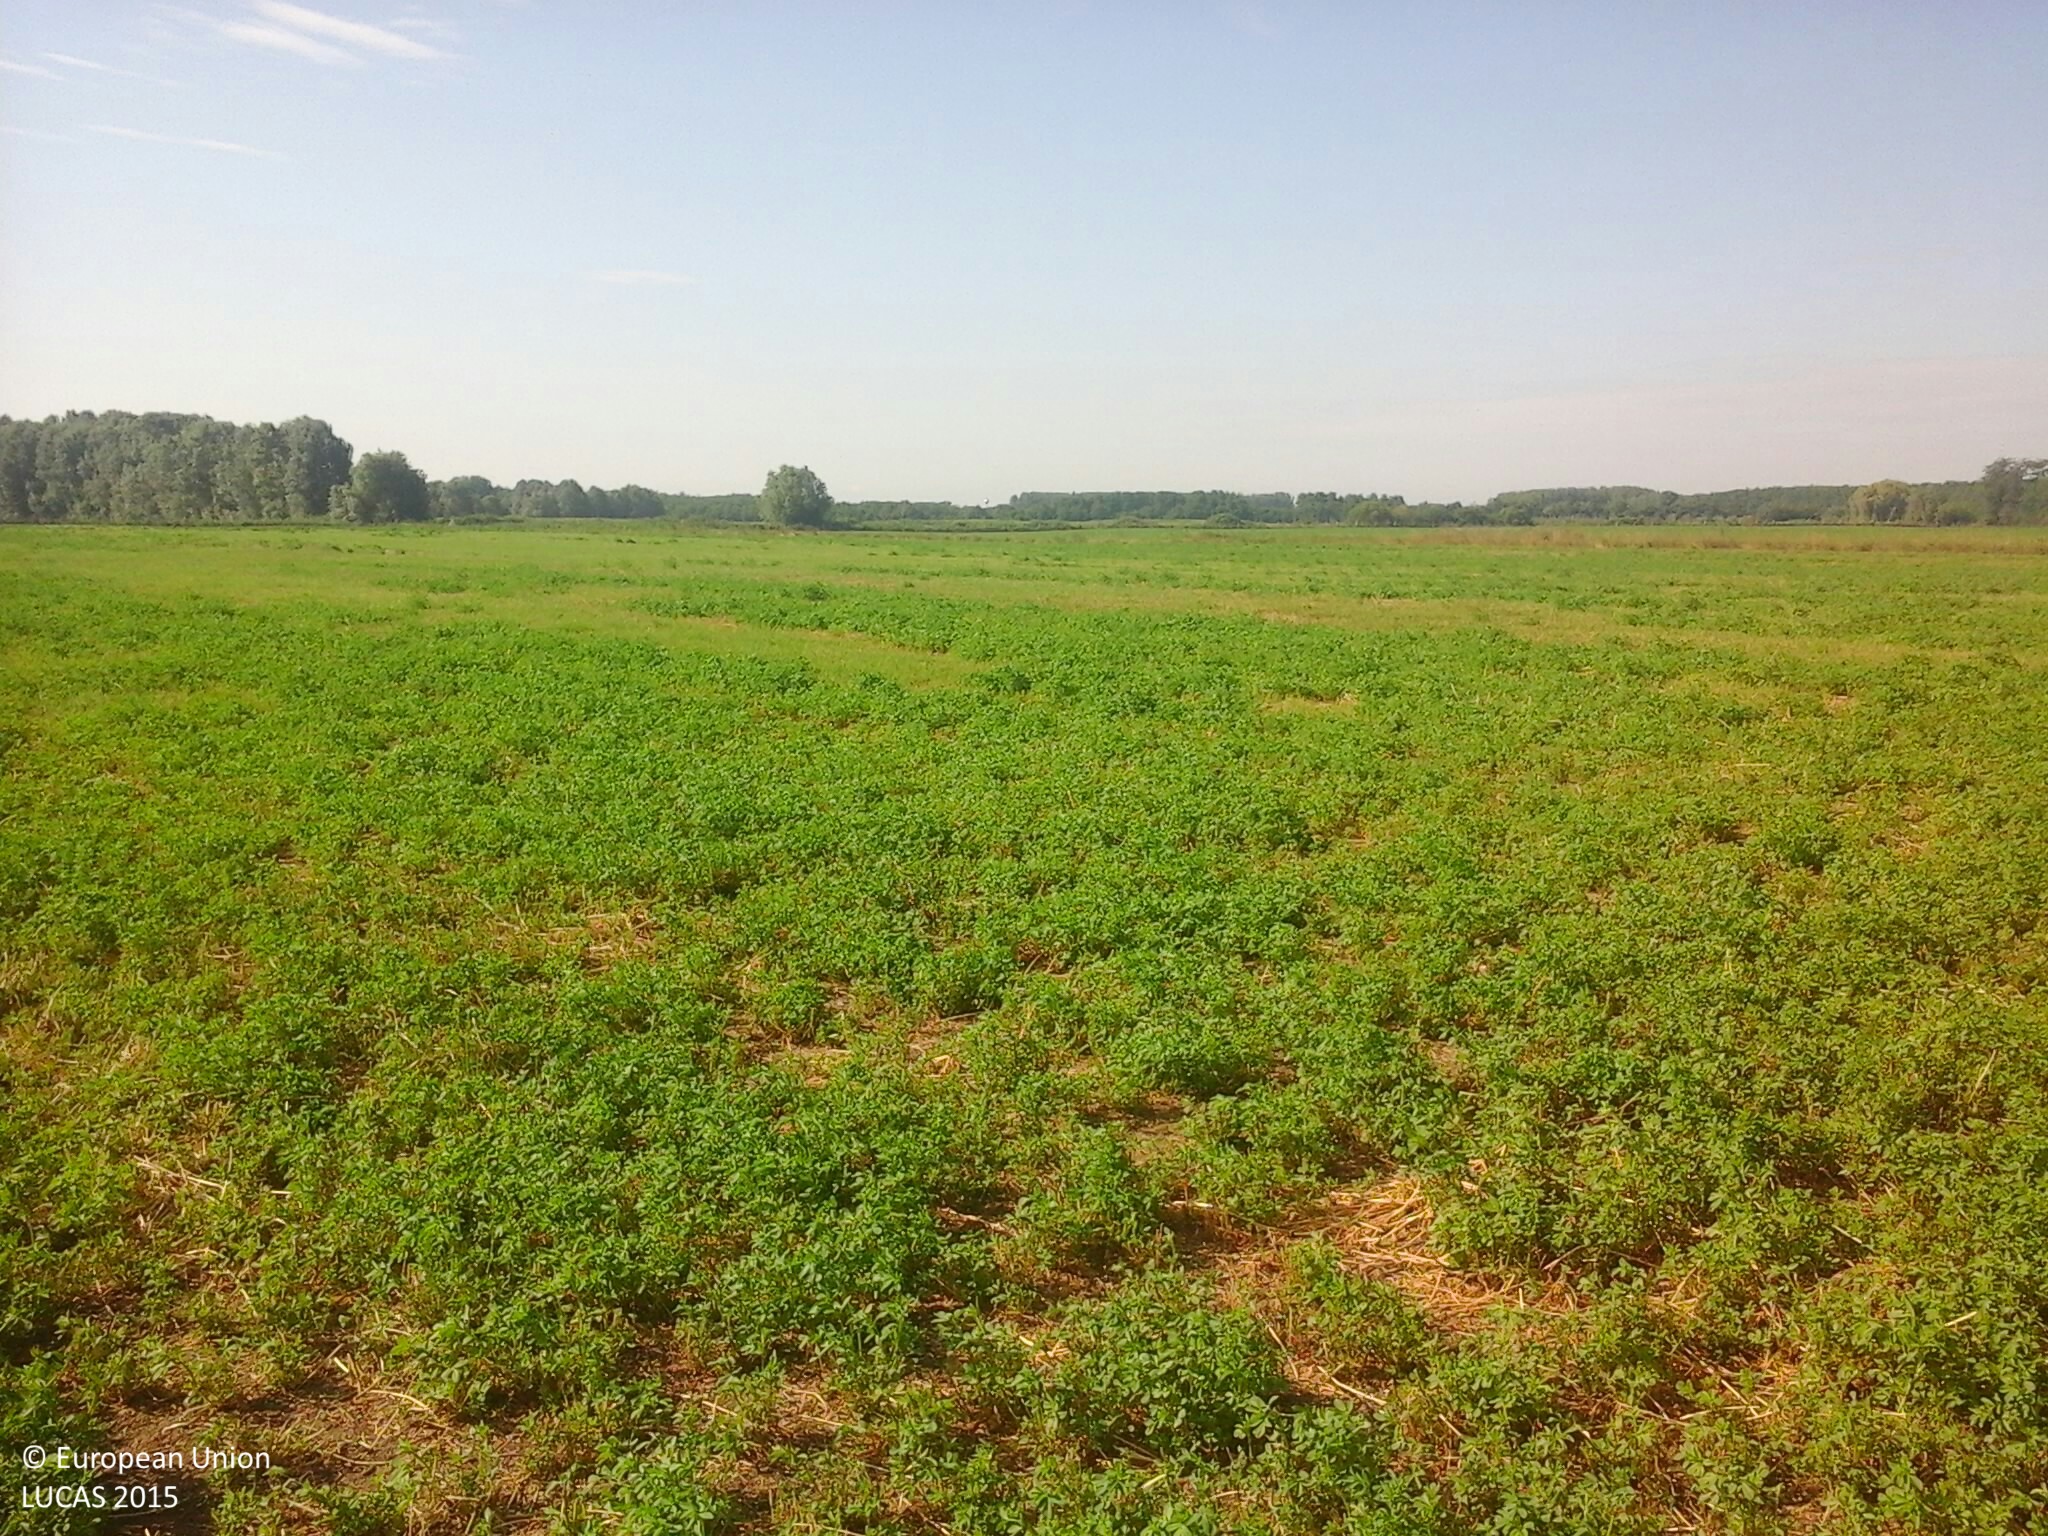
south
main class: Cropland
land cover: Lucerne
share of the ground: > 75 %
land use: Agriculture (excluding fallow land and kitchen gardens)
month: July
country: HU
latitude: 47.8018
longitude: 22.1635
